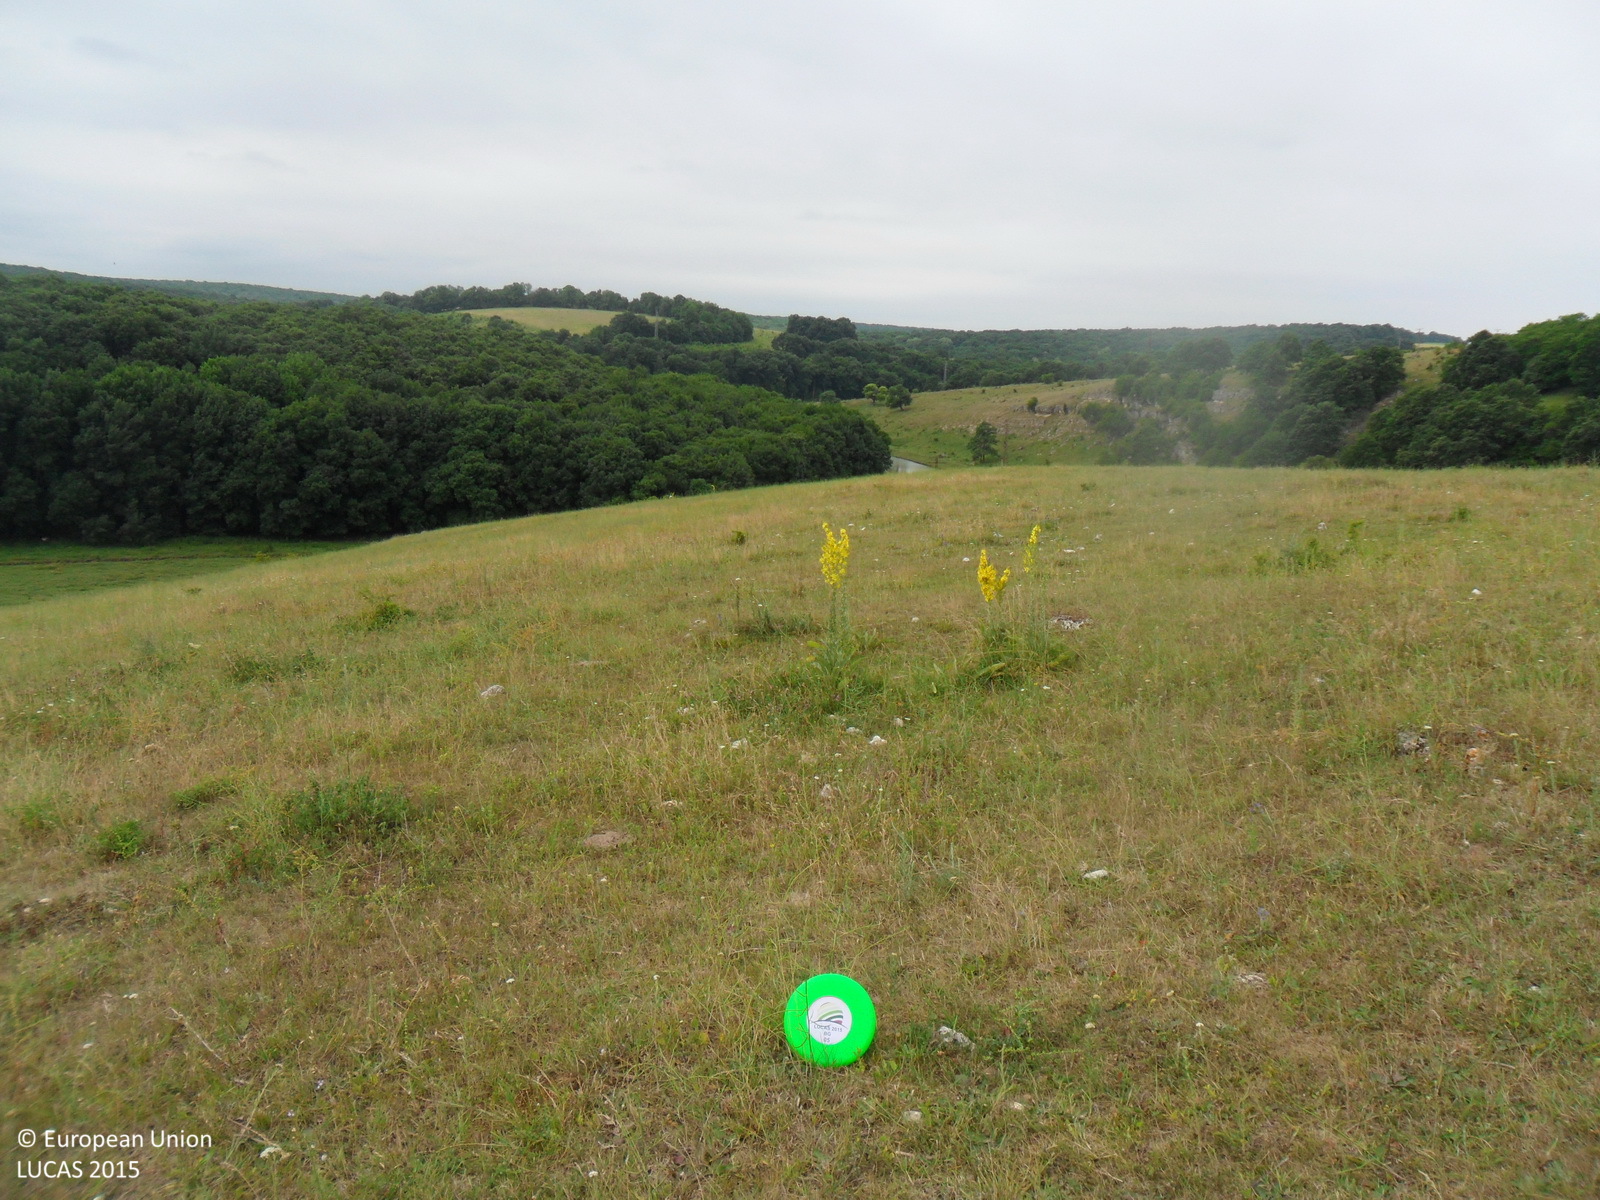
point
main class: Grassland
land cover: Grassland without tree/shrub cover
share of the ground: > 75 %
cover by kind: herbaceous plants 100 %
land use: Agriculture (excluding fallow land and kitchen gardens)
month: June
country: BG
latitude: 43.7373
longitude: 26.7132
